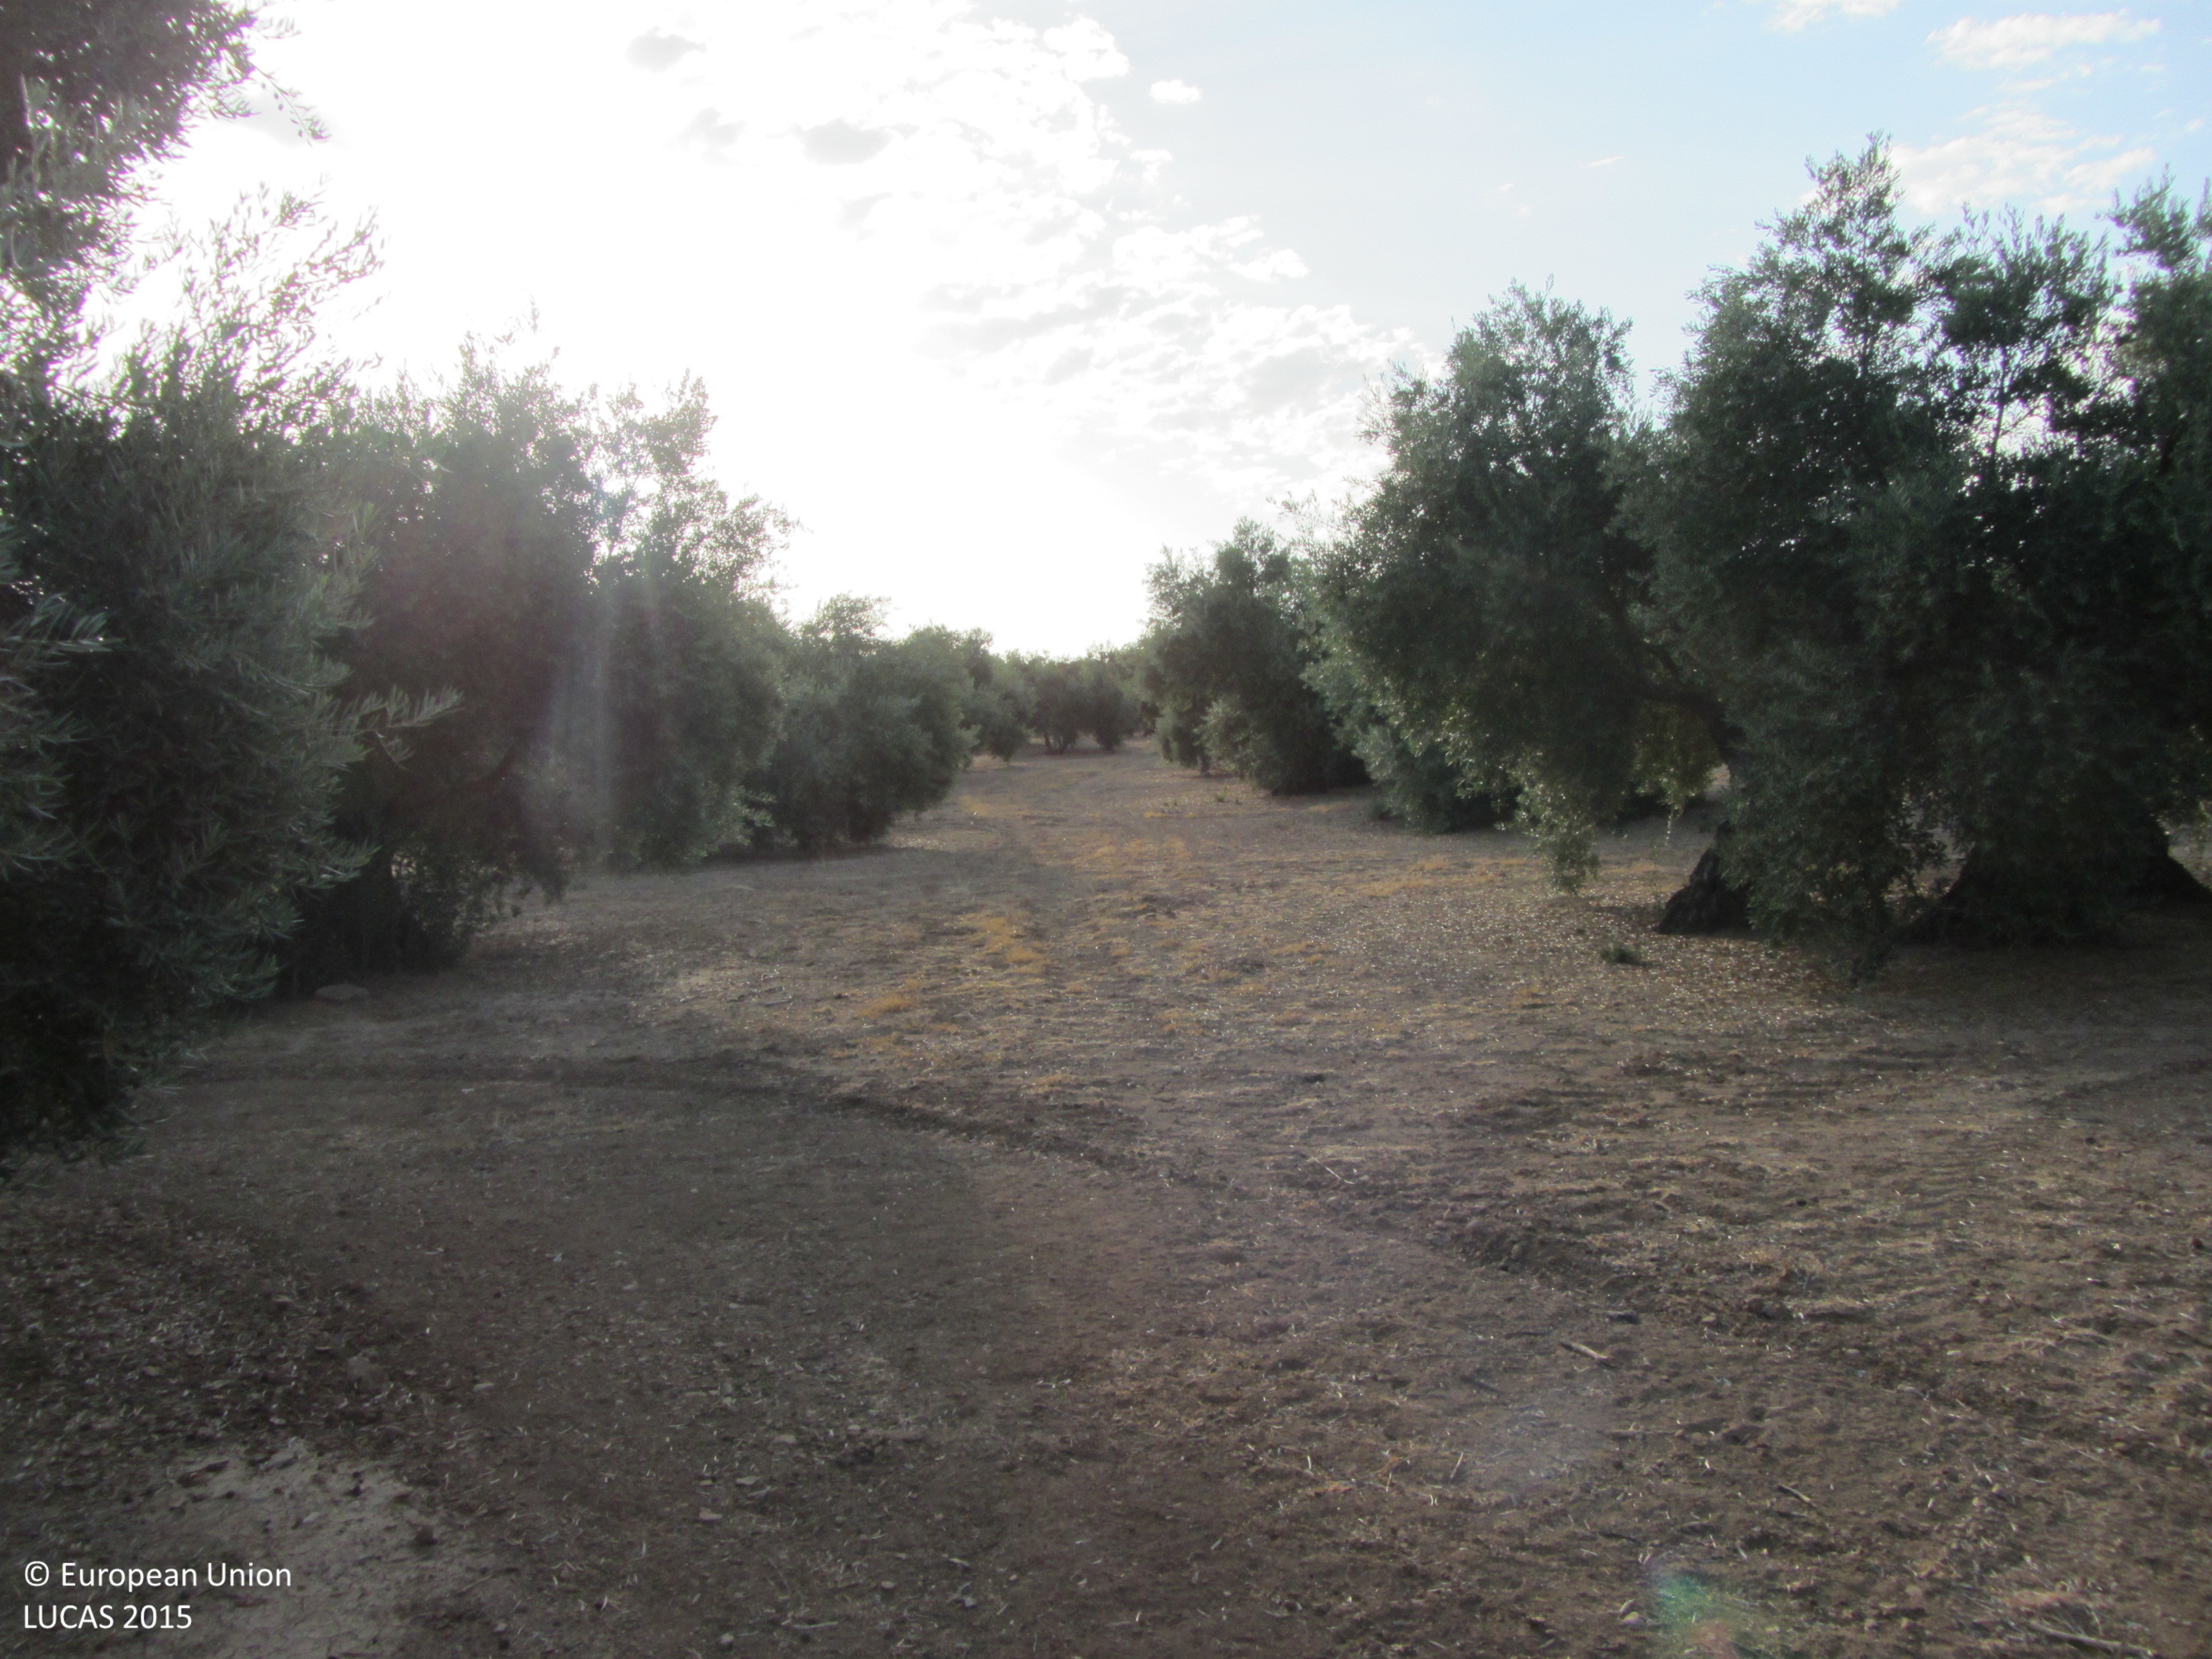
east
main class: Cropland
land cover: Olive groves
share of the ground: 25 - 50 %
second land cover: Other bare soil
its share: > 75 %
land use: Agriculture (excluding fallow land and kitchen gardens)
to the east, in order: Olive groves; Other bare soil; Dry stone walls; Abandoned hedges; Olive groves
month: July
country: ES
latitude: 38.0406
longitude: -3.4119
